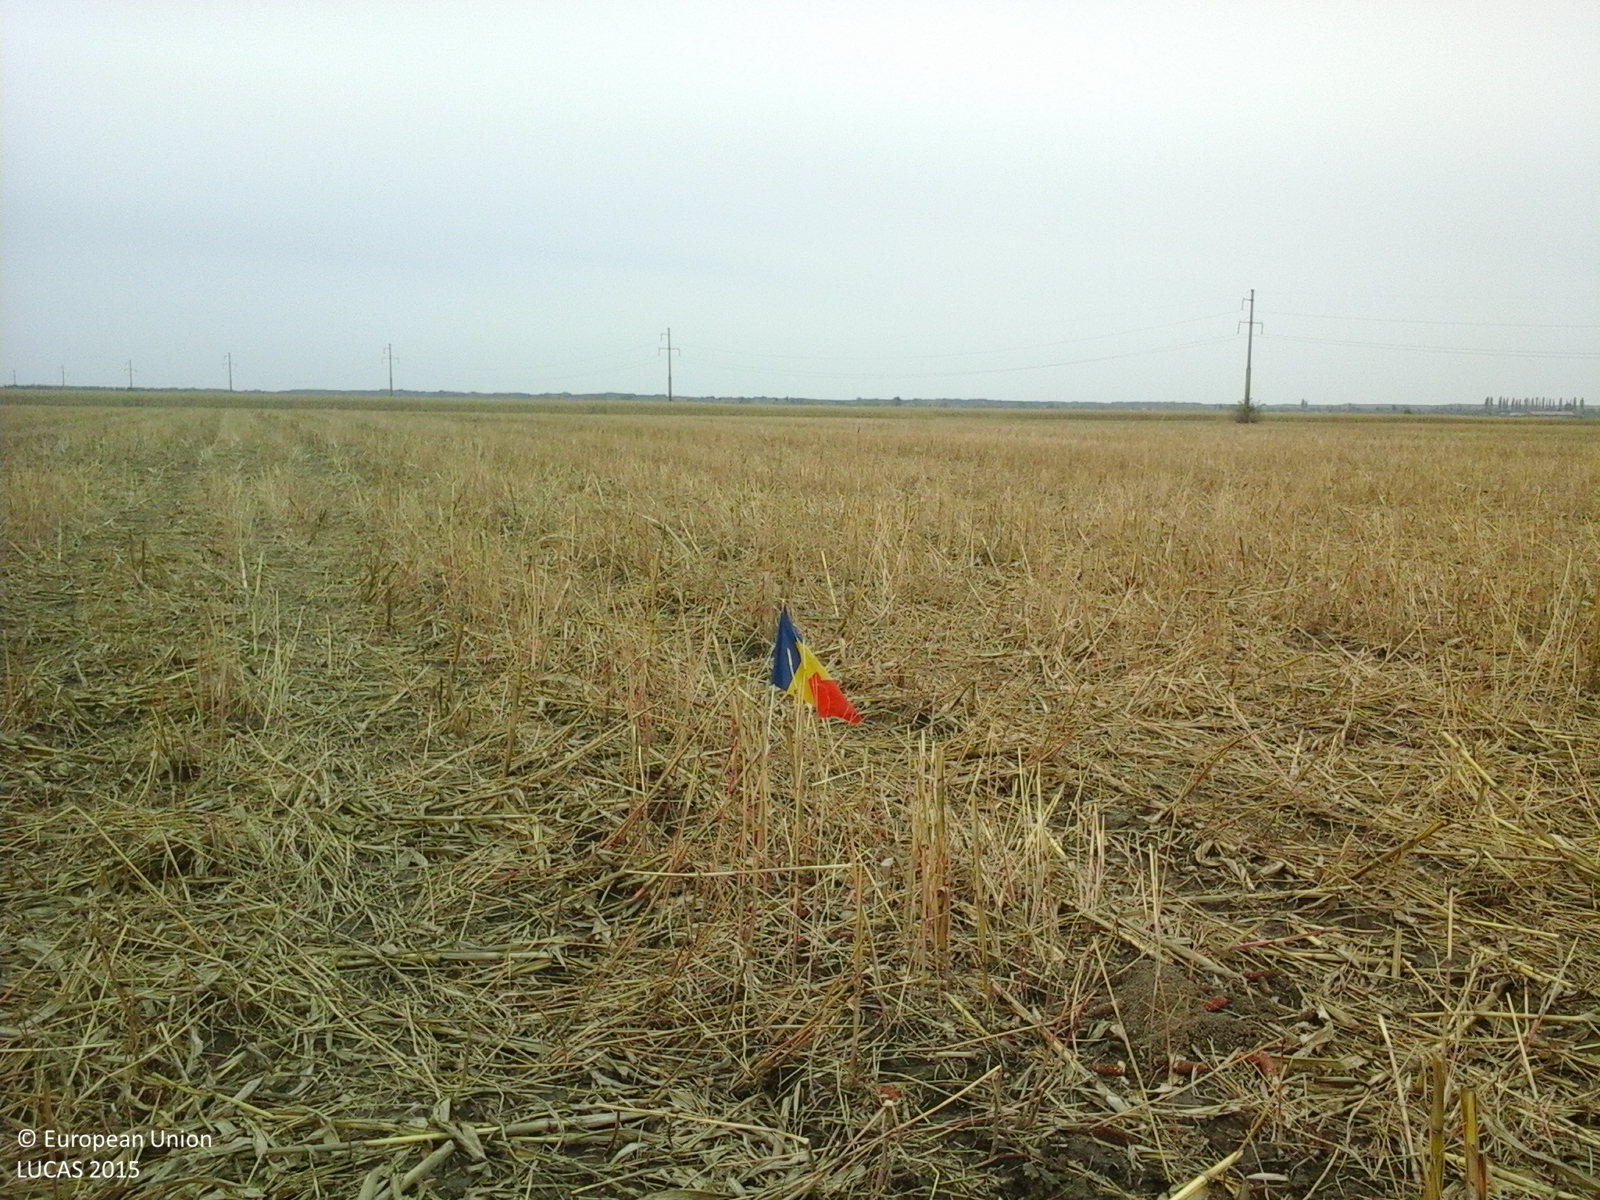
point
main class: Cropland
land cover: Maize
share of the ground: 10 - 25 %
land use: Agriculture (excluding fallow land and kitchen gardens)
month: October
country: RO
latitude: 44.8518
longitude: 26.2977
